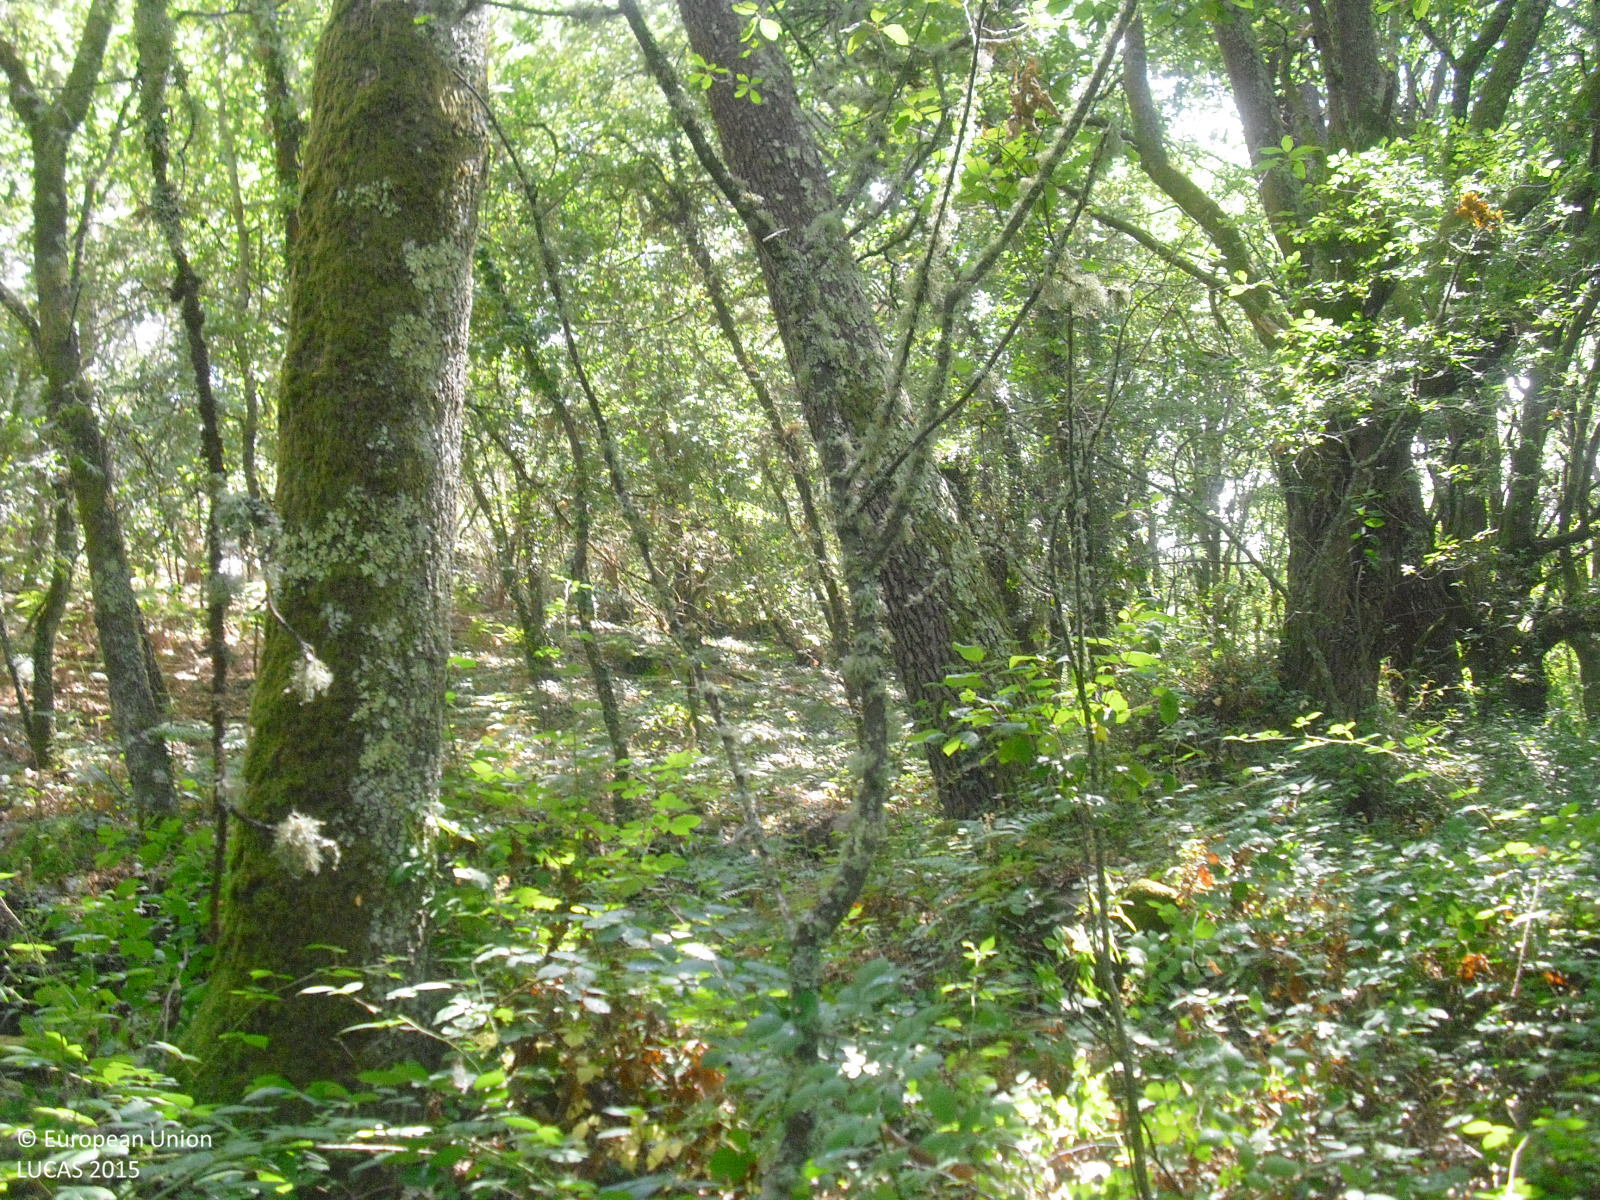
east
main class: Woodland
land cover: Broadleaved woodland
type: thermophilous deciduous forest
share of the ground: > 75 %
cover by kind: broadleaved forest trees 90 %, shrubs 10 %
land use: Forestry
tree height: > 5 m
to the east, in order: Broadleaved woodland; Dry stone walls; Broadleaved woodland; Dry stone walls; Broadleaved woodland; Dry stone walls; Grassland with sparse tree/shrub cover; Shrubland with sparse tree cover; Dry stone walls; Broadleaved woodland; Fences; Dry stone walls; Tracks; Broadleaved woodland; Electric lines; Pine dominated mixed woodland; Tracks; Pine dominated mixed woodland
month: July
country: ES
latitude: 42.3817
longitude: -7.7463
